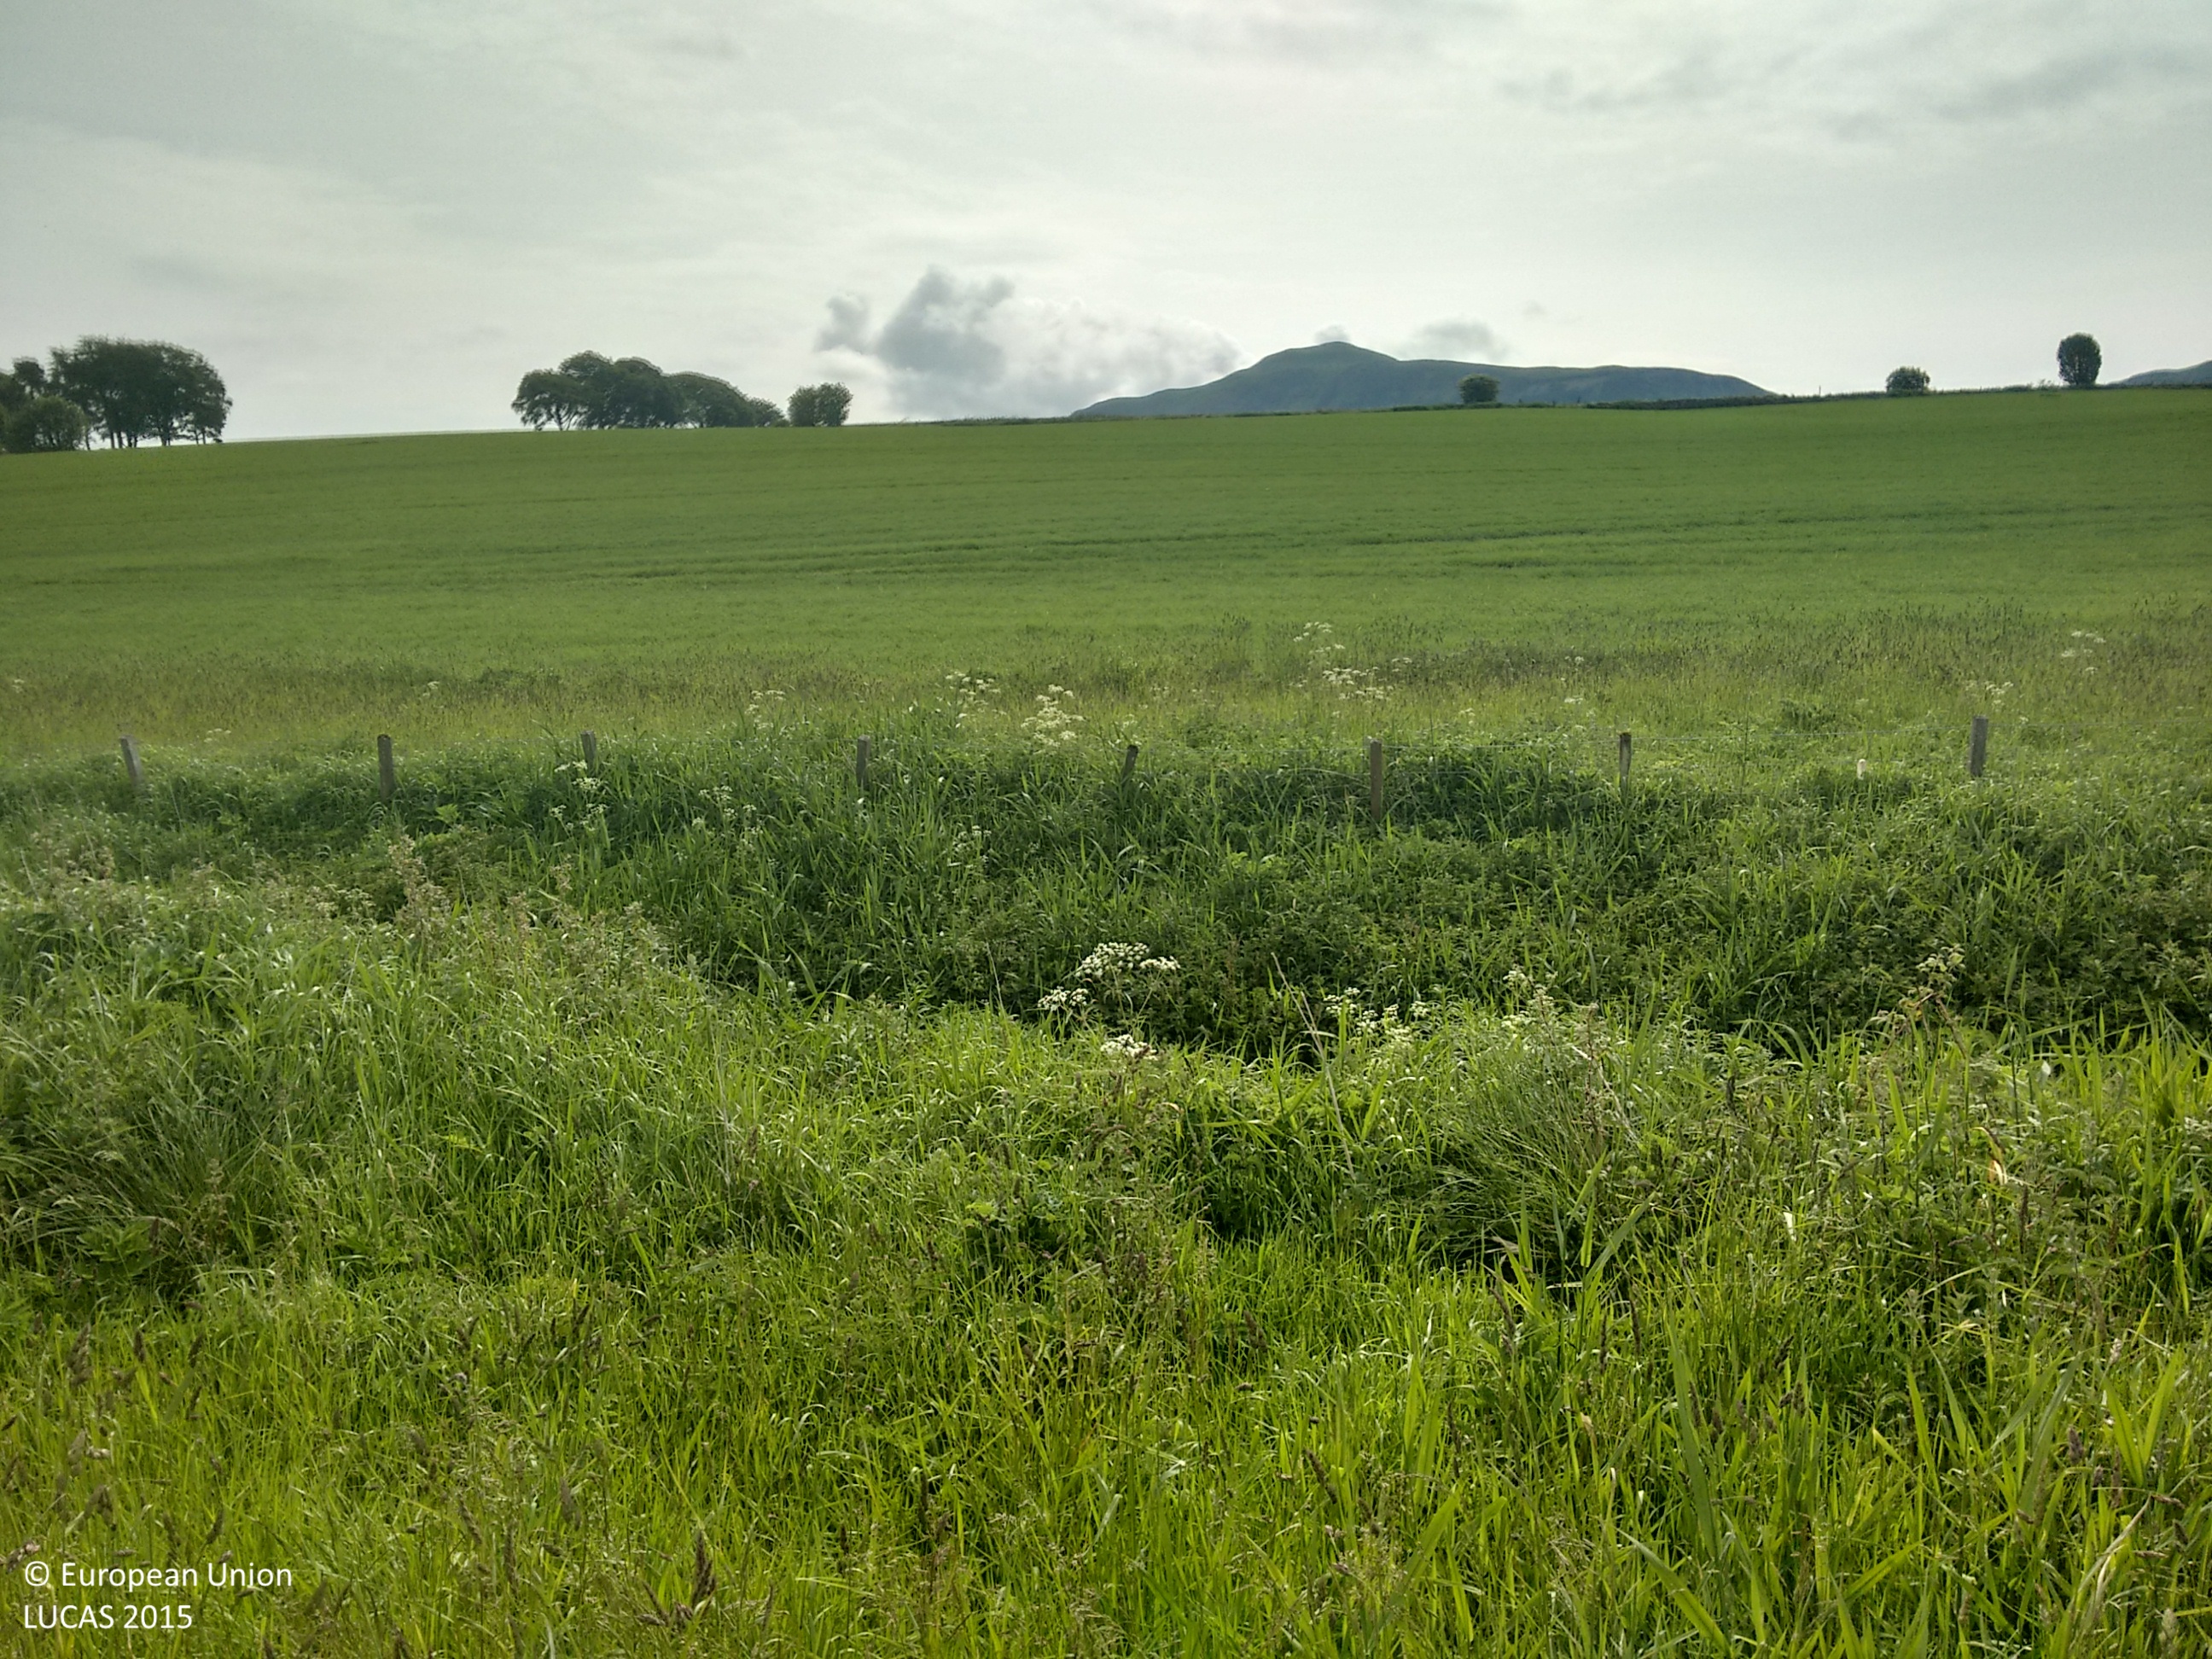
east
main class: Cropland
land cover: Barley
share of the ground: > 75 %
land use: Agriculture (excluding fallow land and kitchen gardens)
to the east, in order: Barley; Grassland without tree/shrub cover; Ditches and canals; Grass margins; Fences; Grassland without tree/shrub cover; Barley; Fences; Dry stone walls; Single bushes/trees; Grass margins; Paved roads, cycling and walking lanes; Grass margins; Ditches and canals; Grass margins; Dry stone walls; Fences; Barley
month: June
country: GB
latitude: 56.2520
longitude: -3.3566
